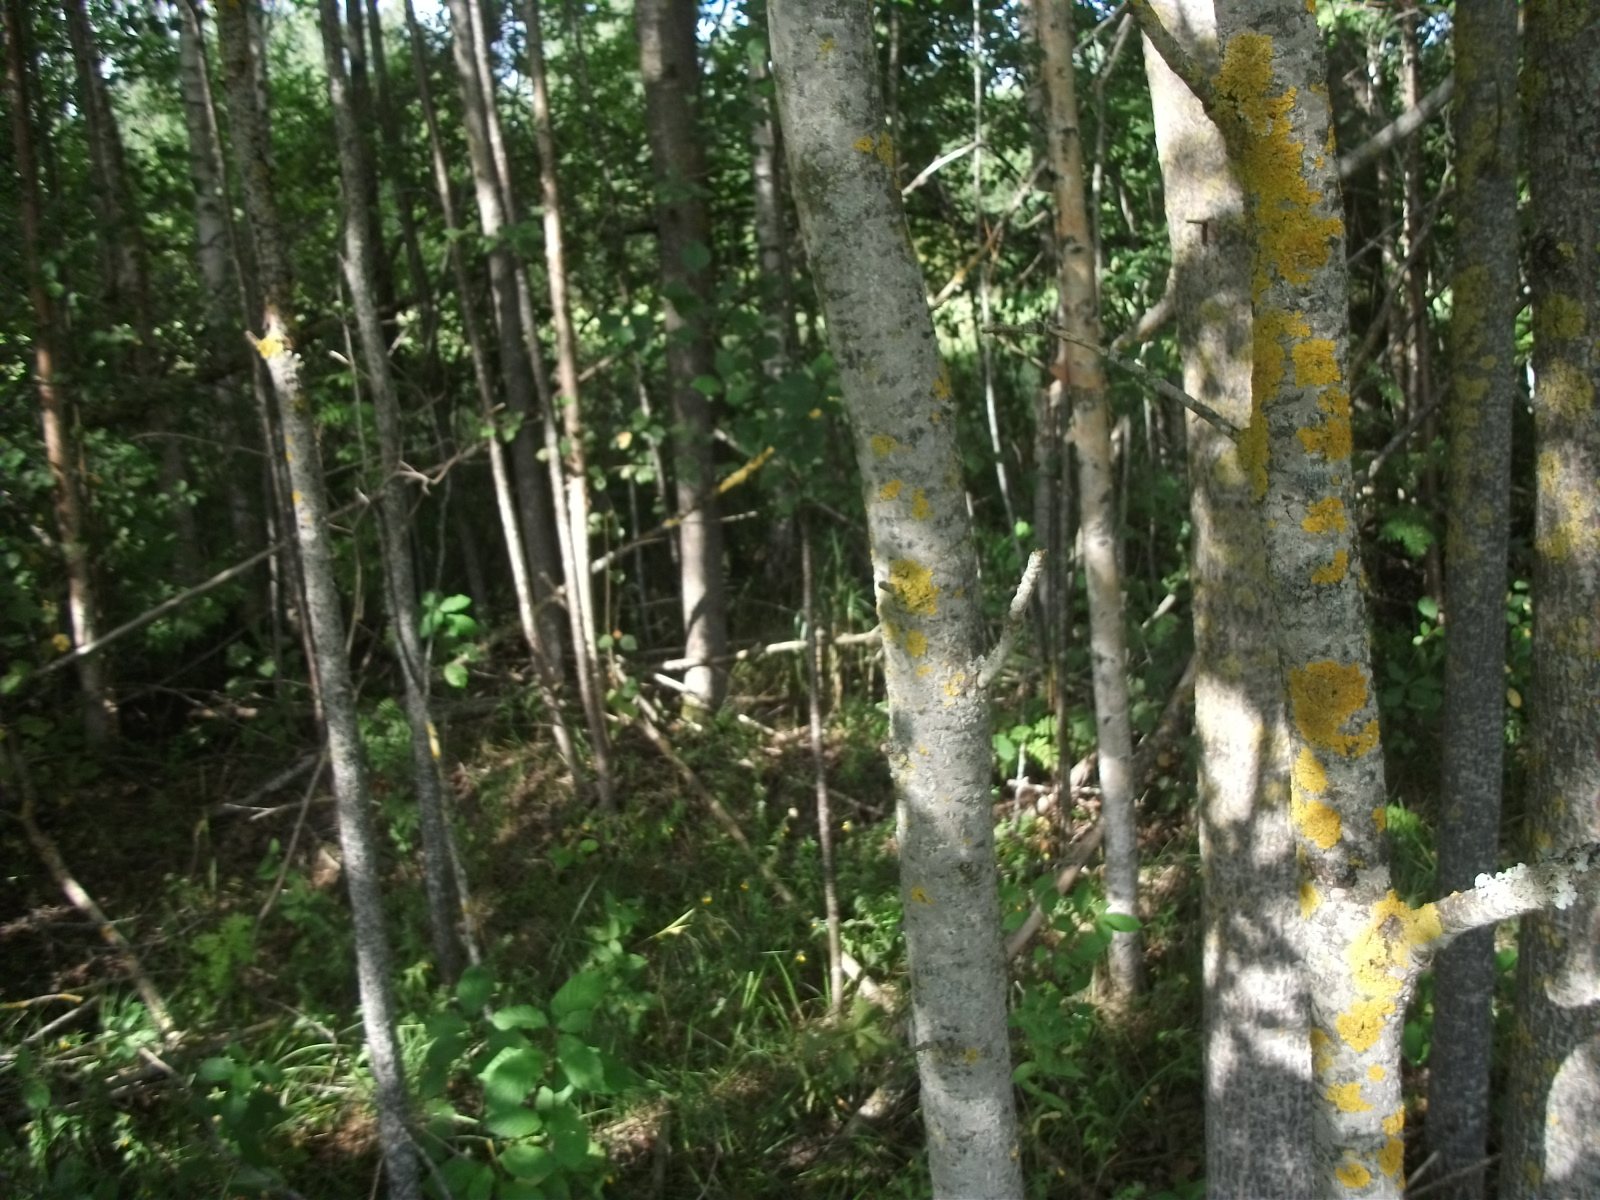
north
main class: Grassland
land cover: Grassland without tree/shrub cover
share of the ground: > 75 %
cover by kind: herbaceous plants 100 %
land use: Agriculture (excluding fallow land and kitchen gardens)
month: August
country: LV
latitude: 56.4873
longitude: 26.3677
